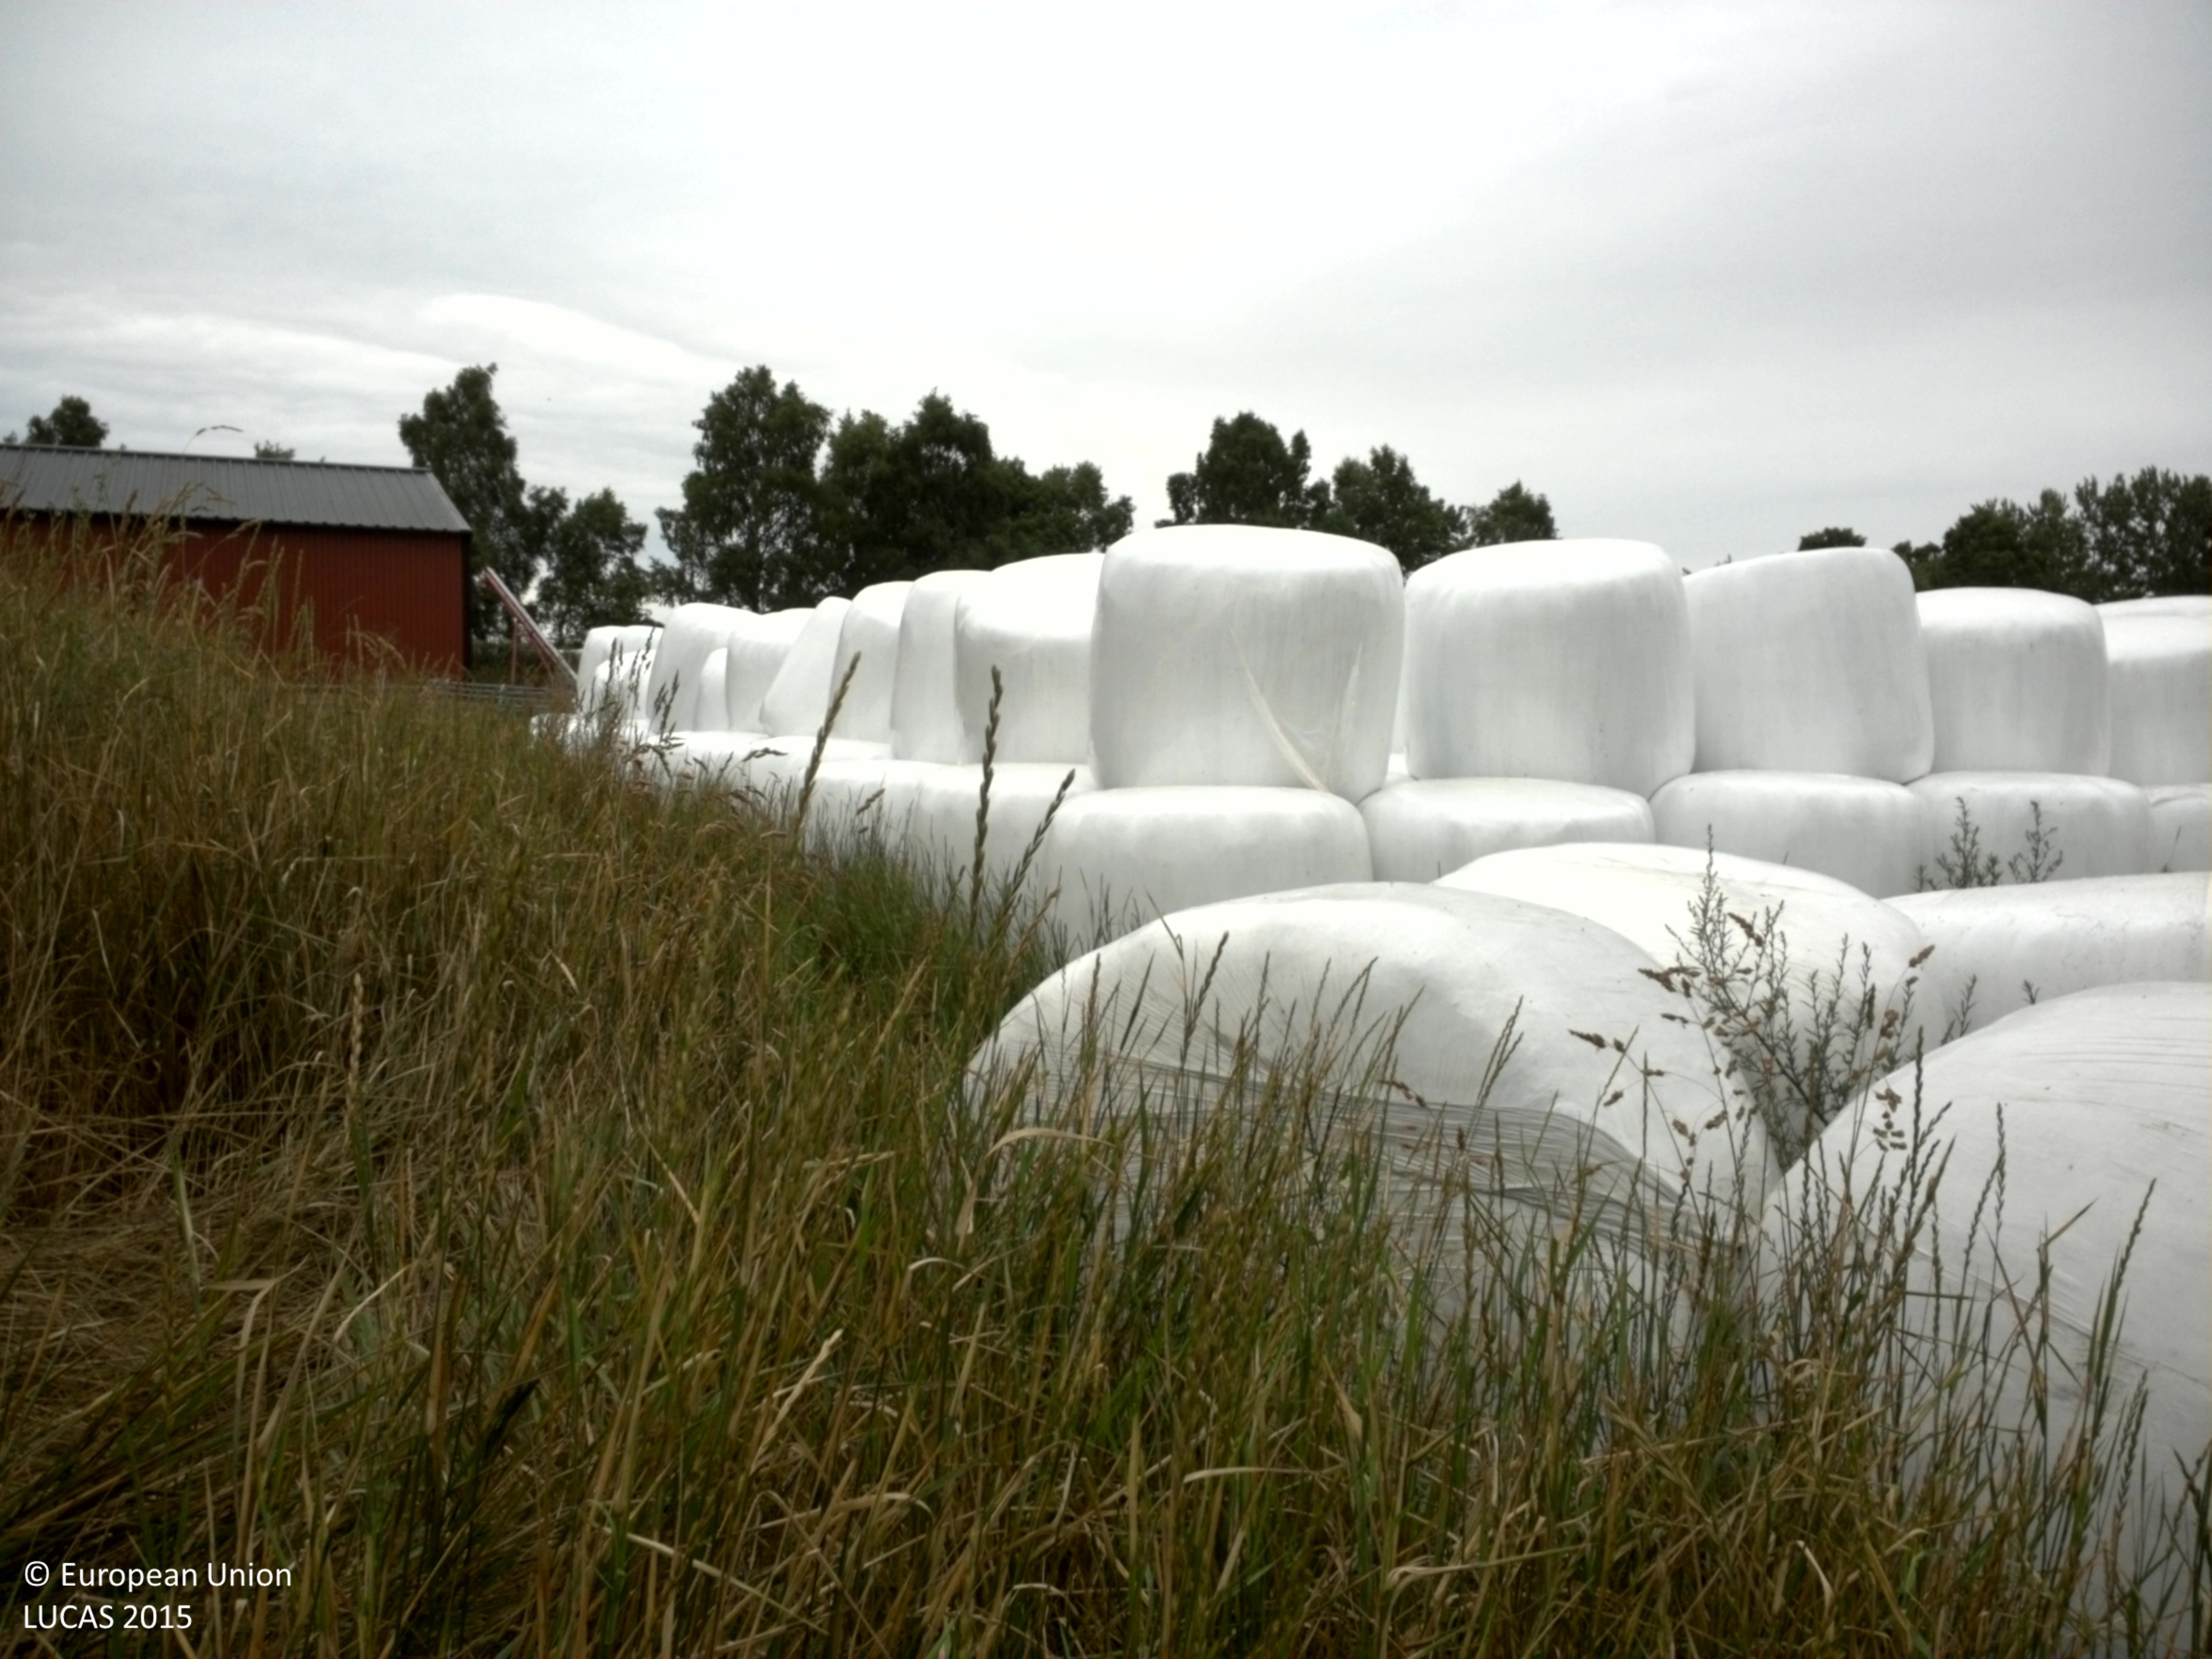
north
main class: Grassland
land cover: Grassland without tree/shrub cover
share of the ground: > 75 %
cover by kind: herbaceous plants 100 %
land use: Agriculture (excluding fallow land and kitchen gardens)
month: July
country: SE
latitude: 57.2371
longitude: 18.6092
